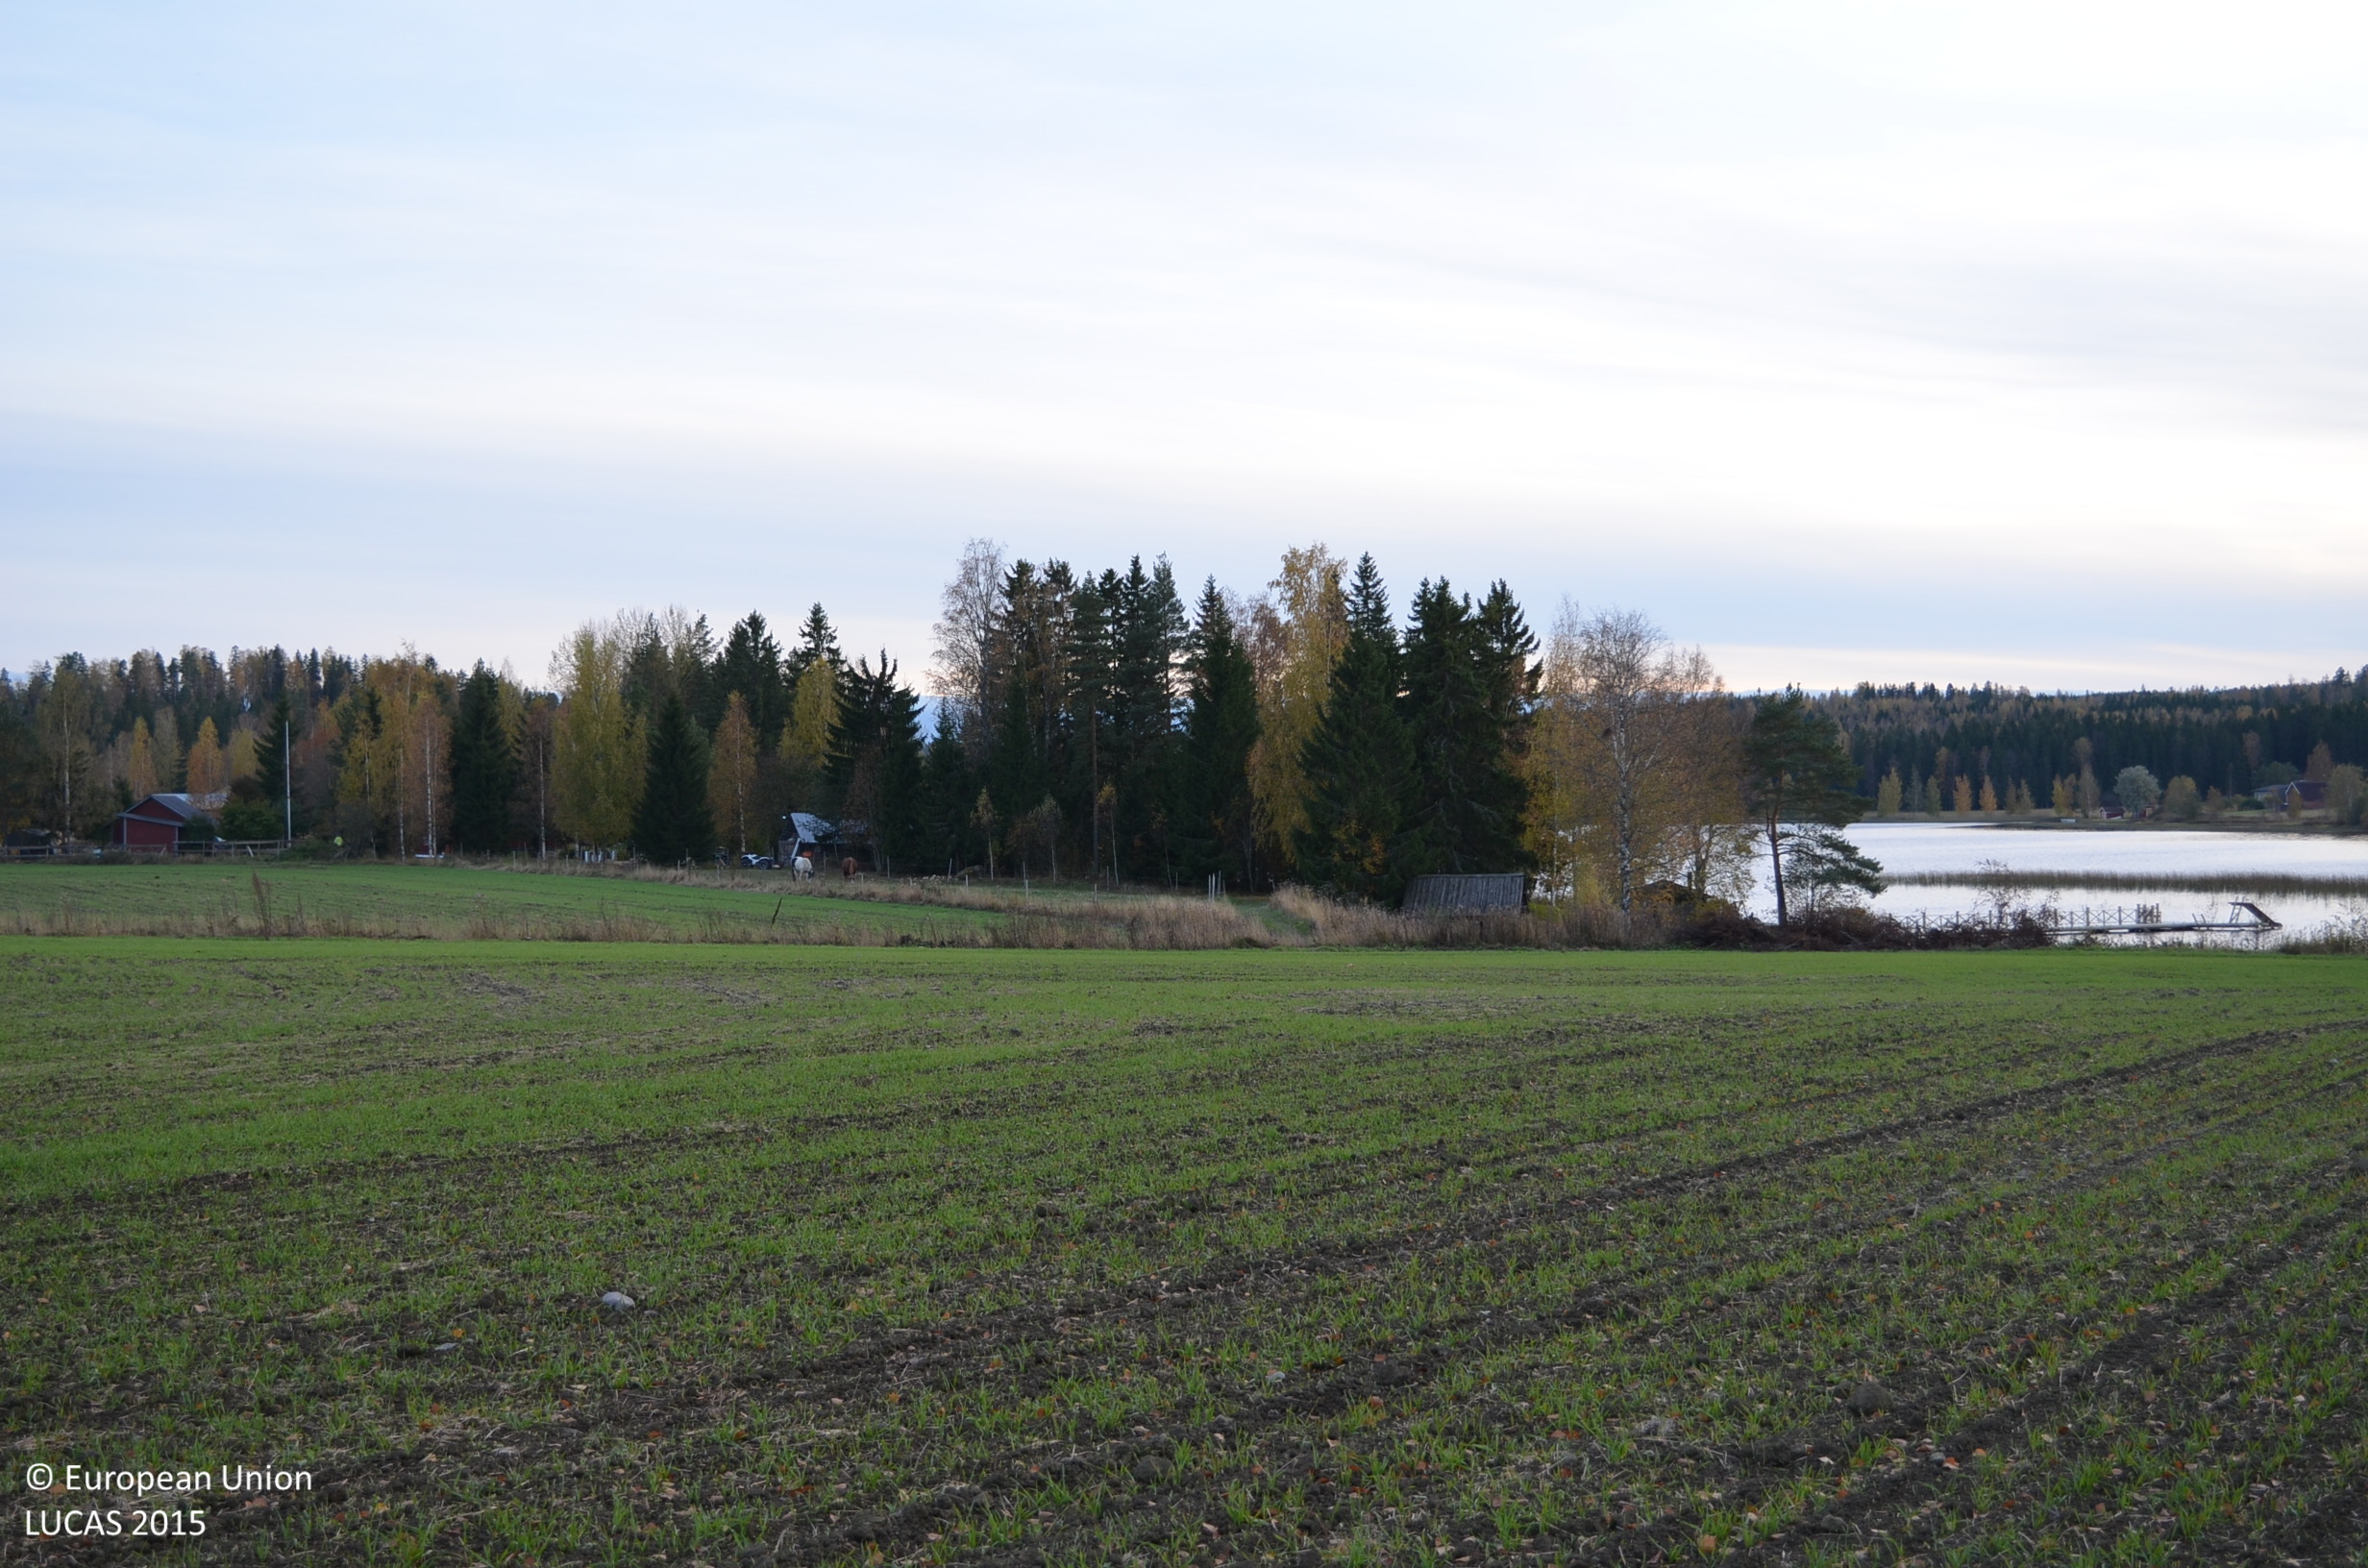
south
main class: Cropland
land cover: Rye
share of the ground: 25 - 50 %
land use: Agriculture (excluding fallow land and kitchen gardens)
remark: Tilled/Sowed
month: October
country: FI
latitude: 61.5214
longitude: 23.3300
